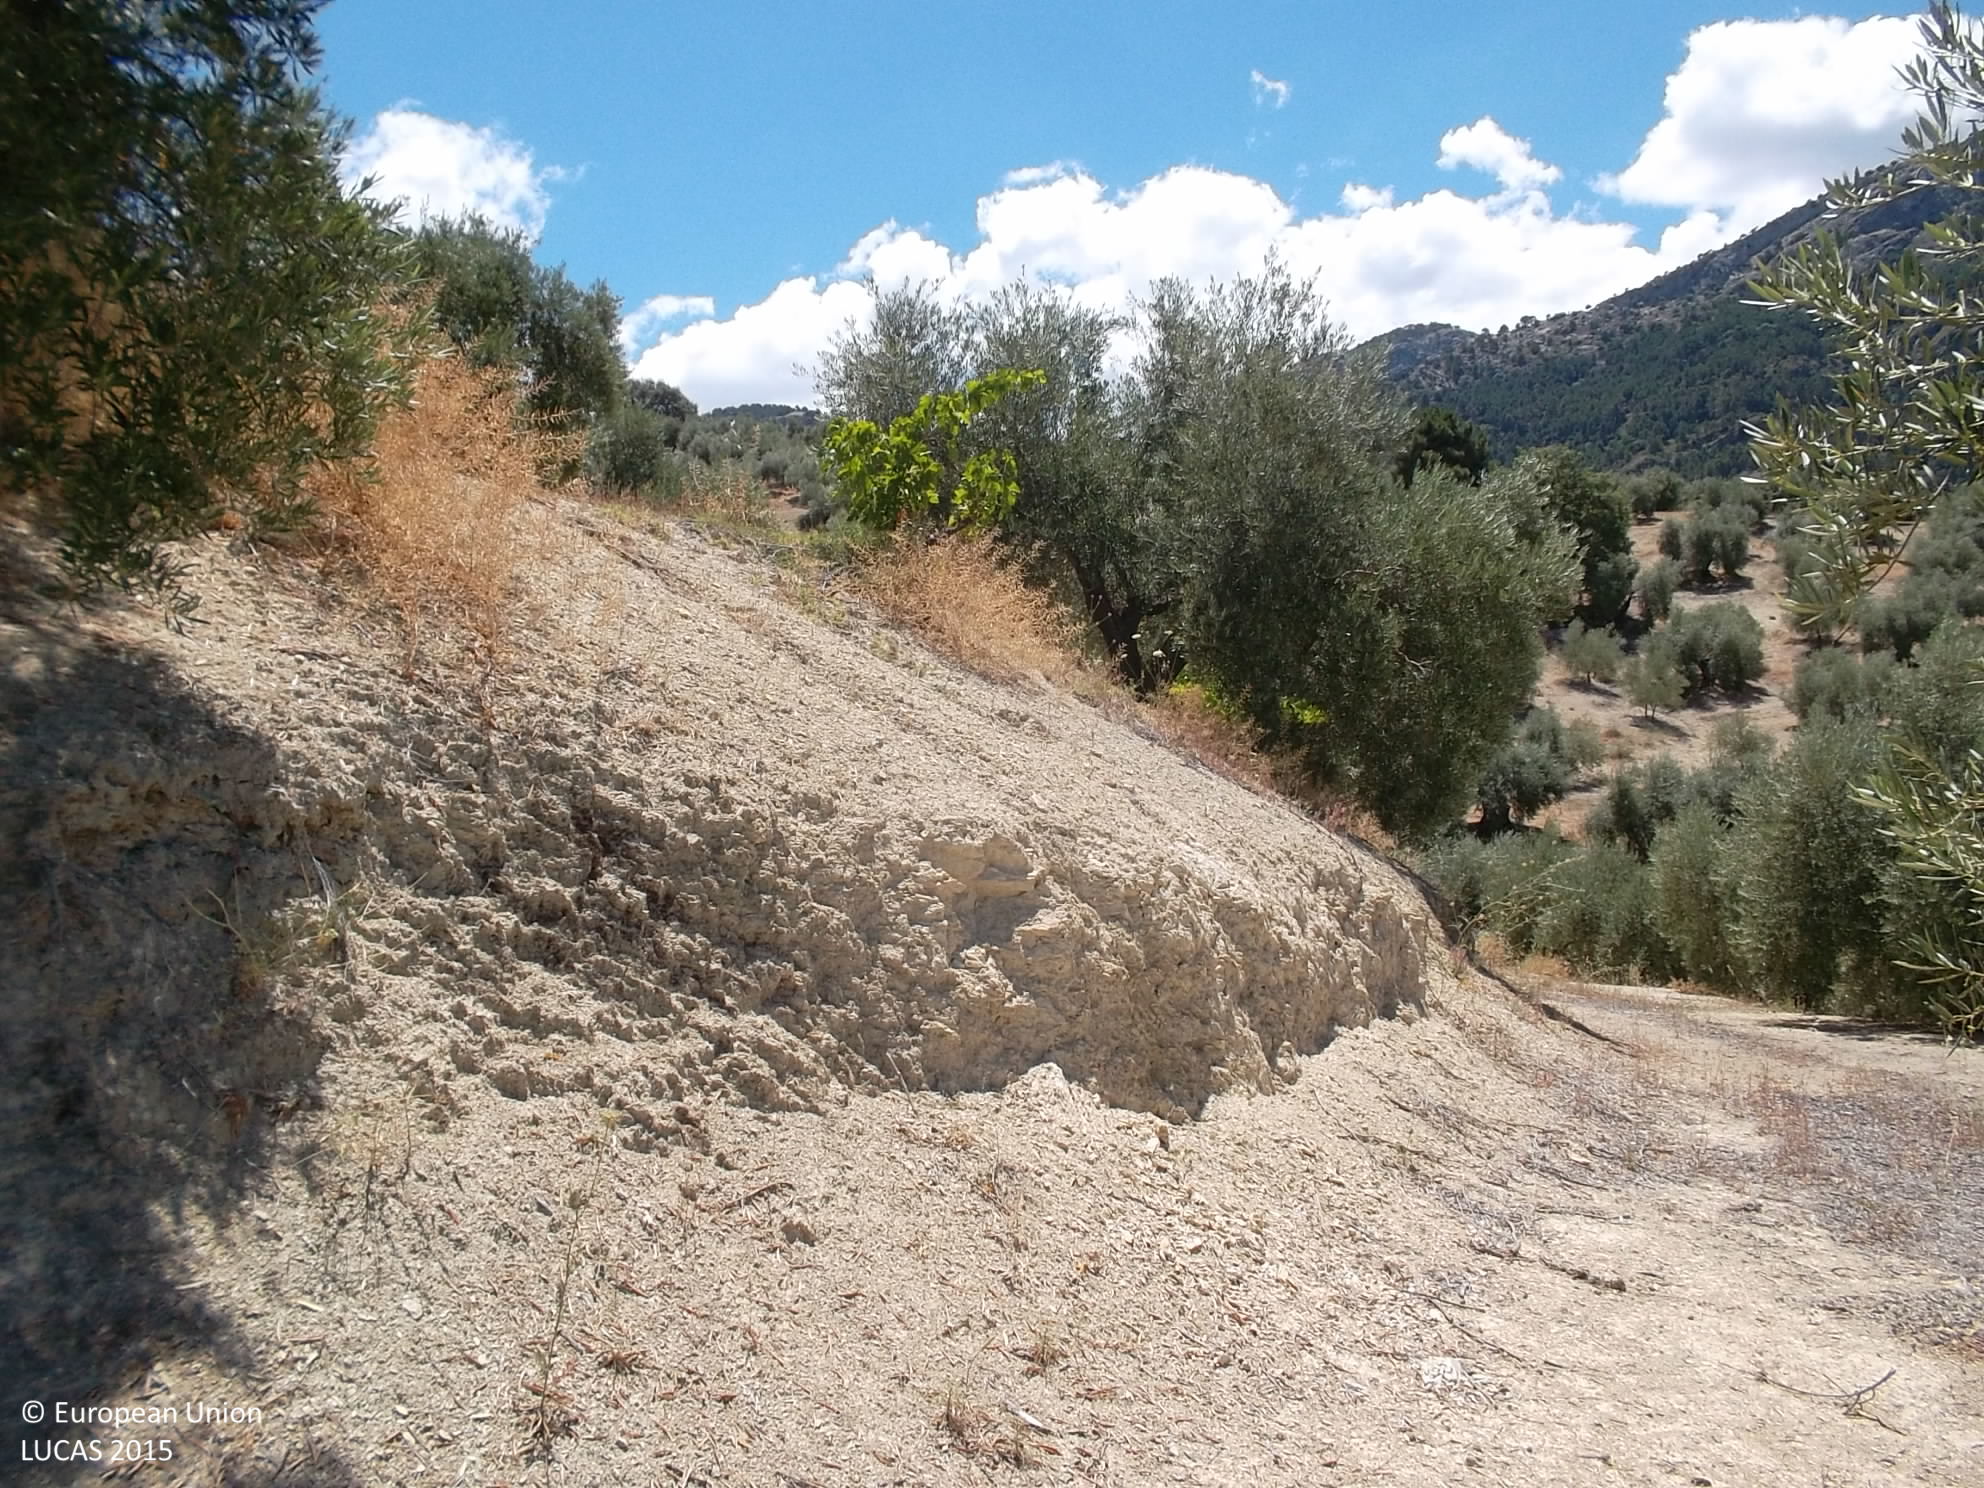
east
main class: Cropland
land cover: Olive groves
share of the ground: 50 - 75 %
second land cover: Other bare soil
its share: > 75 %
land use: Agriculture (excluding fallow land and kitchen gardens)
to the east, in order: Olive groves; Other bare soil; Tracks; Olive groves
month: June
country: ES
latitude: 37.9361
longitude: -2.9777
